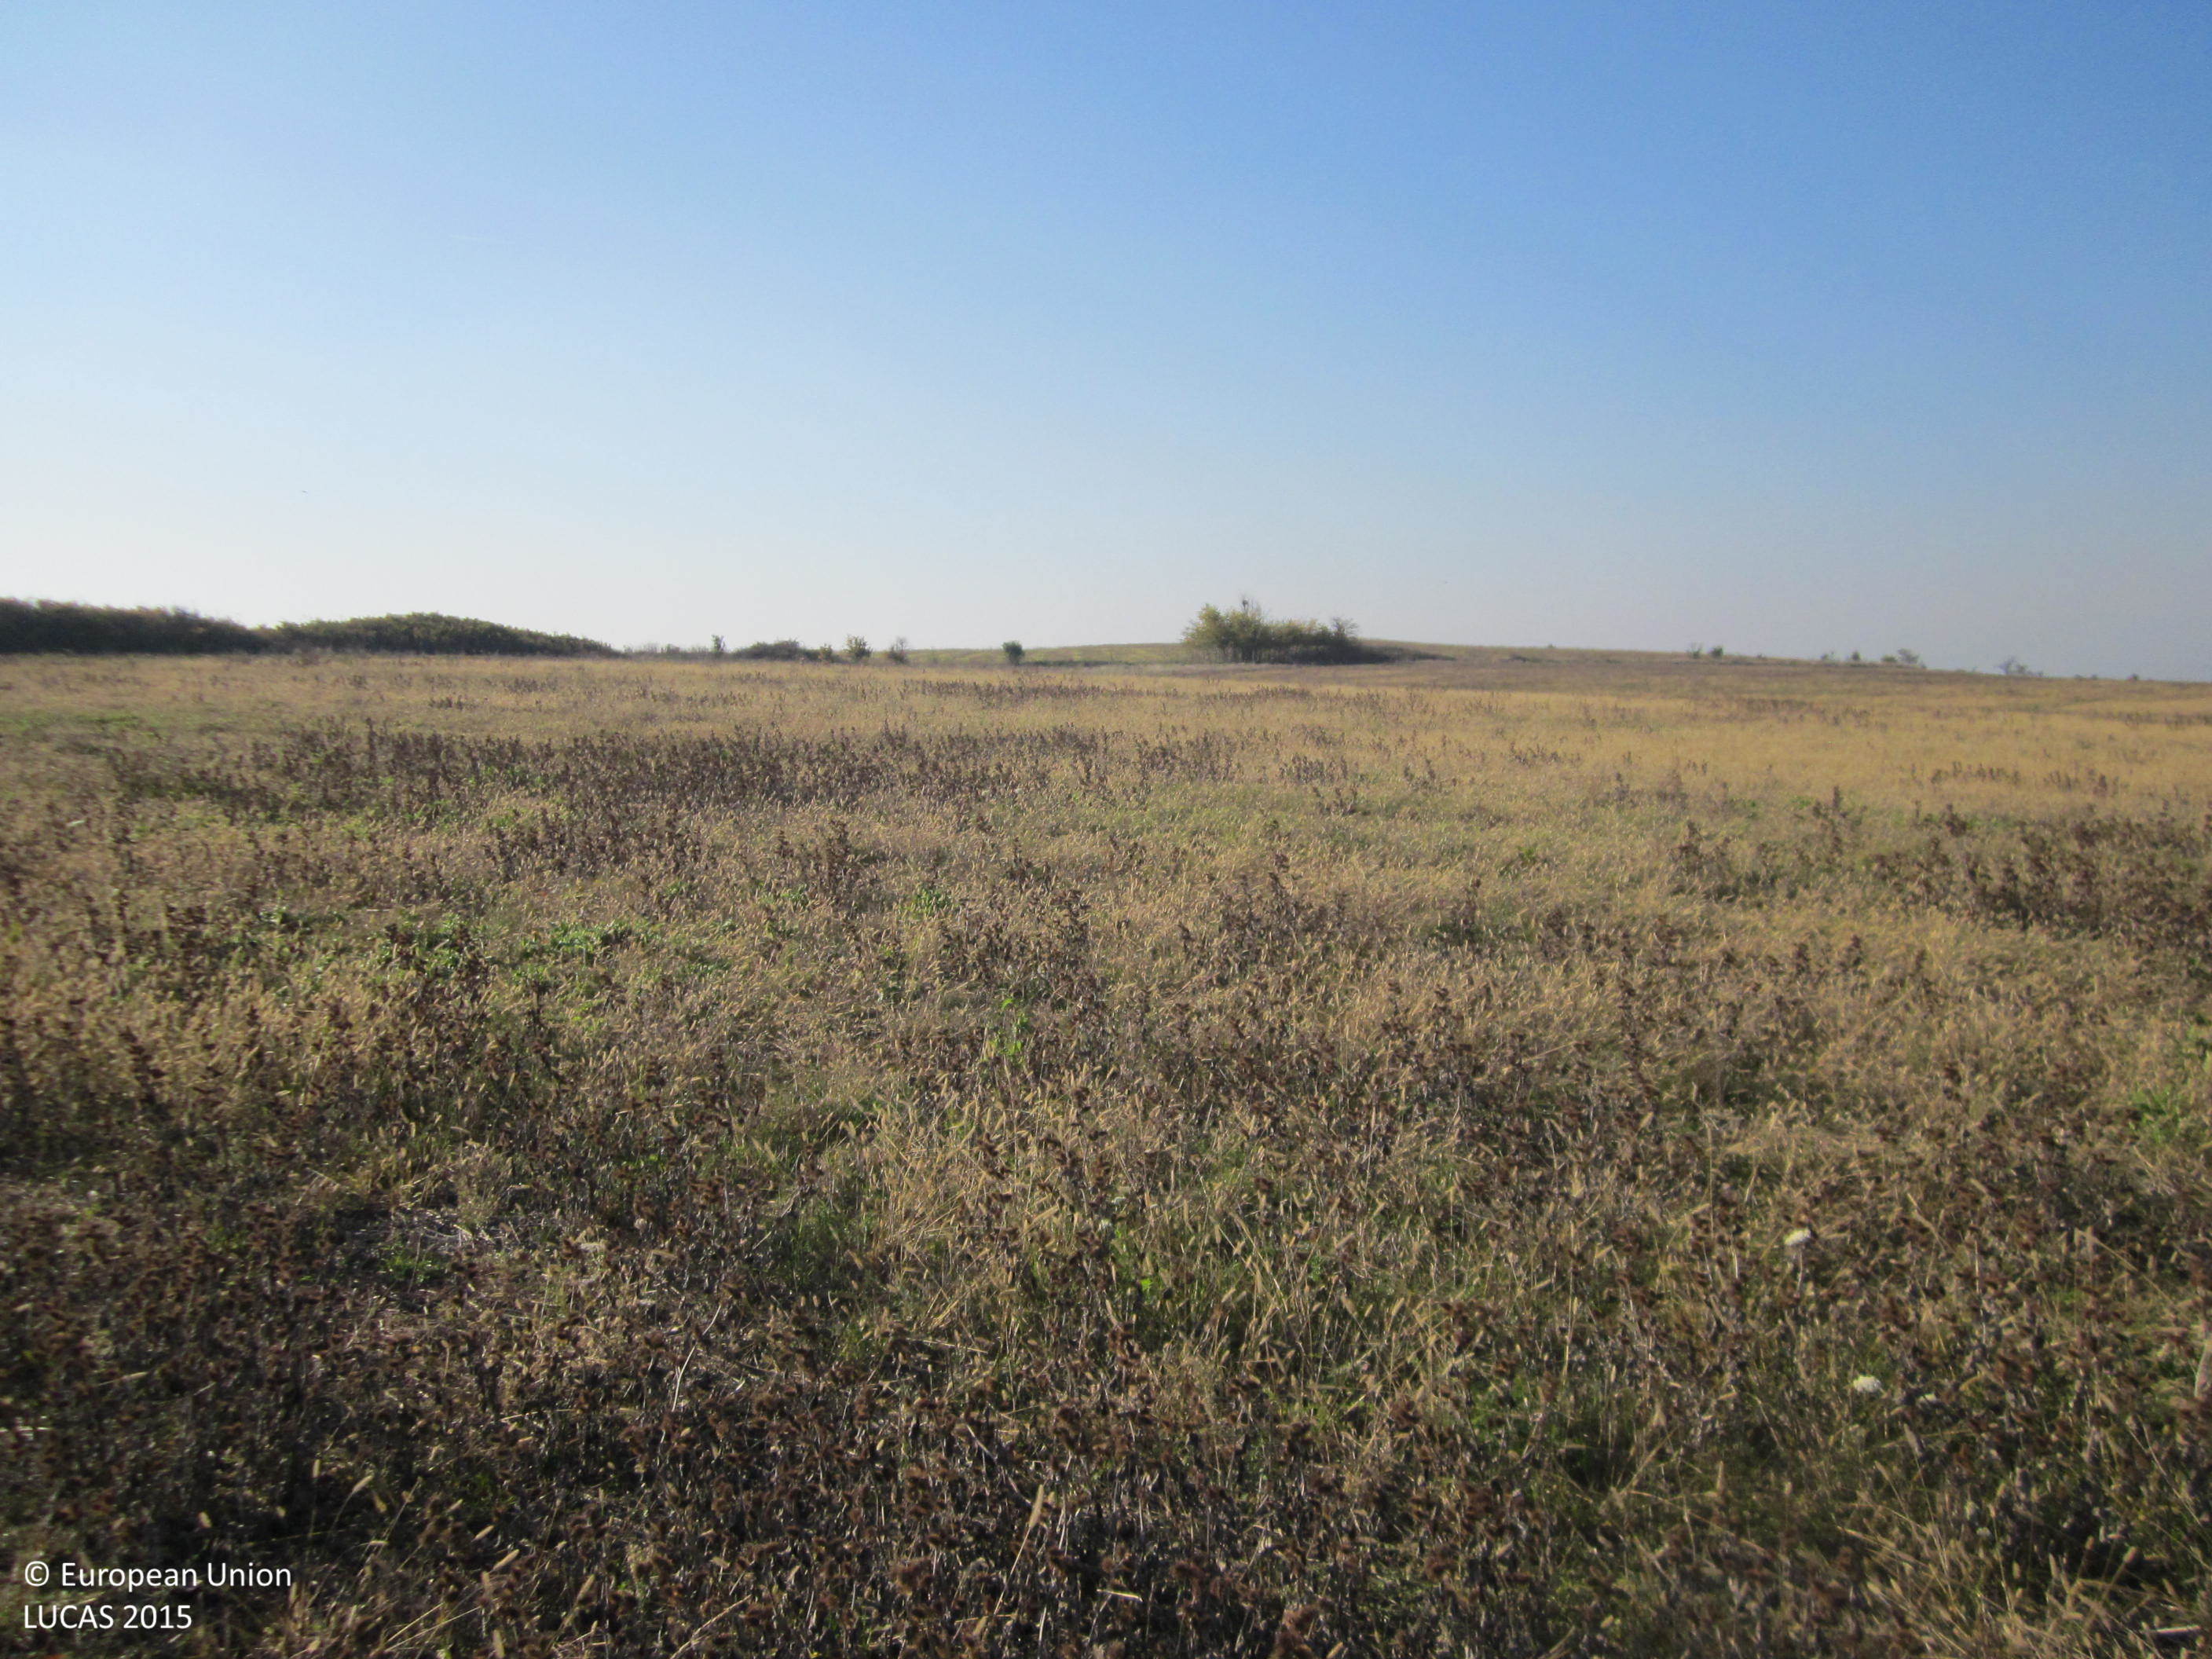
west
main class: Grassland
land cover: Spontaneously vegetated surfaces
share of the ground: > 75 %
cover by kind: herbaceous plants 100 %
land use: Fallow land
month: November
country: BG
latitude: 42.4039
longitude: 24.6694
